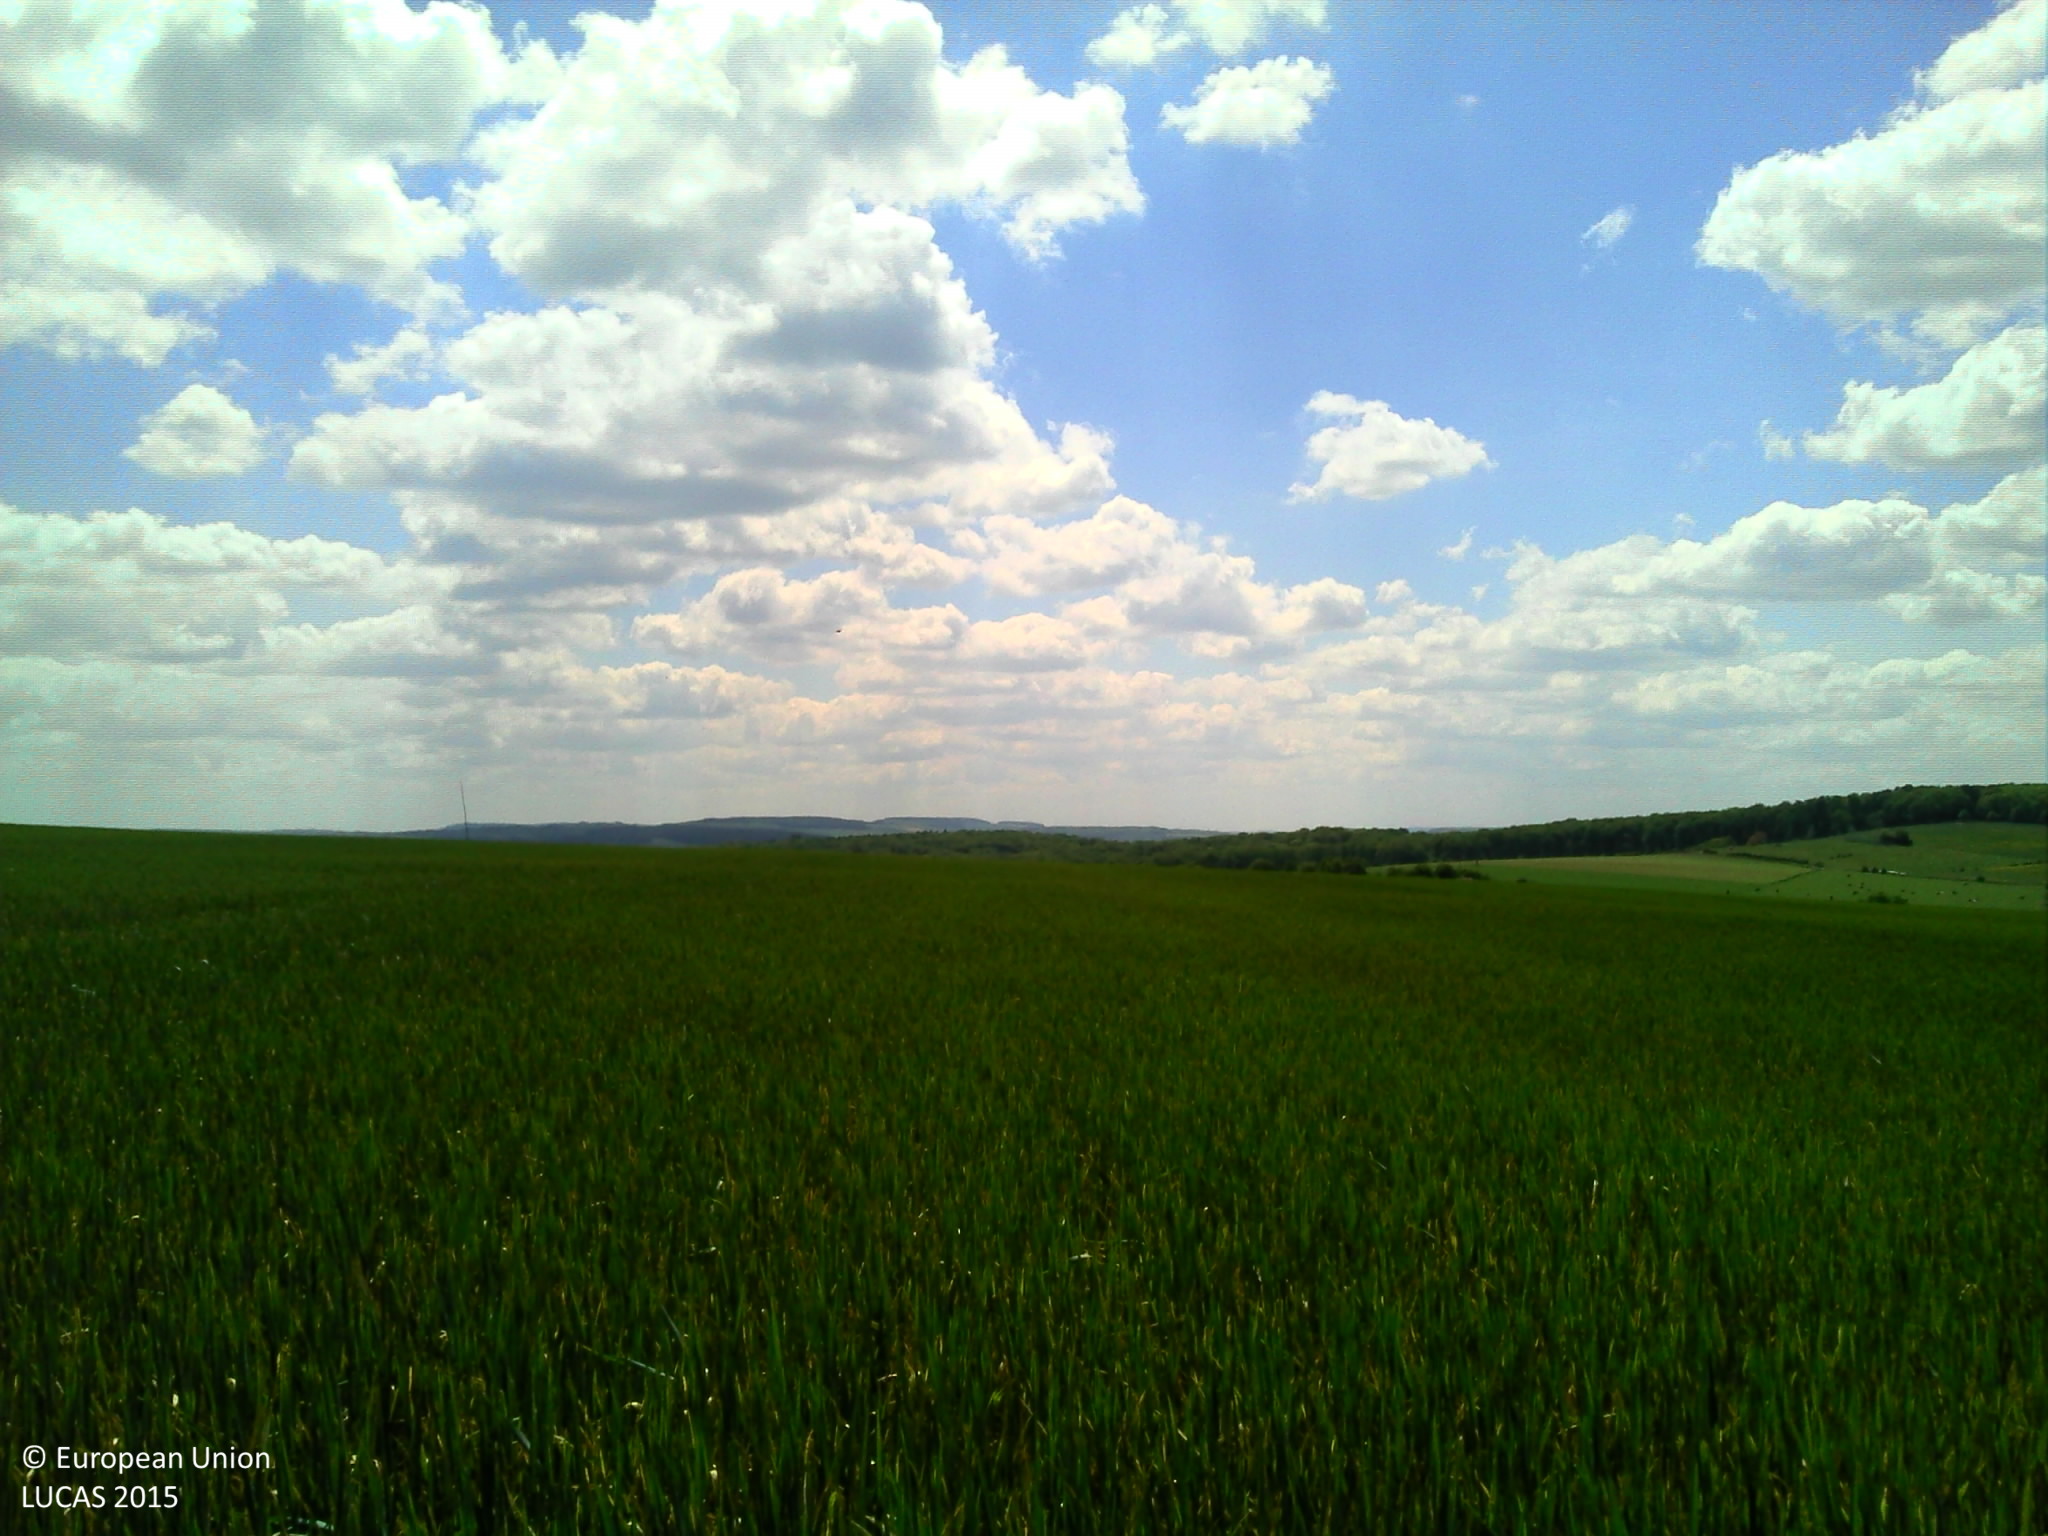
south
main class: Cropland
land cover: Common wheat
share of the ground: > 75 %
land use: Agriculture (excluding fallow land and kitchen gardens)
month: May
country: LU
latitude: 49.7522
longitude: 6.4882
